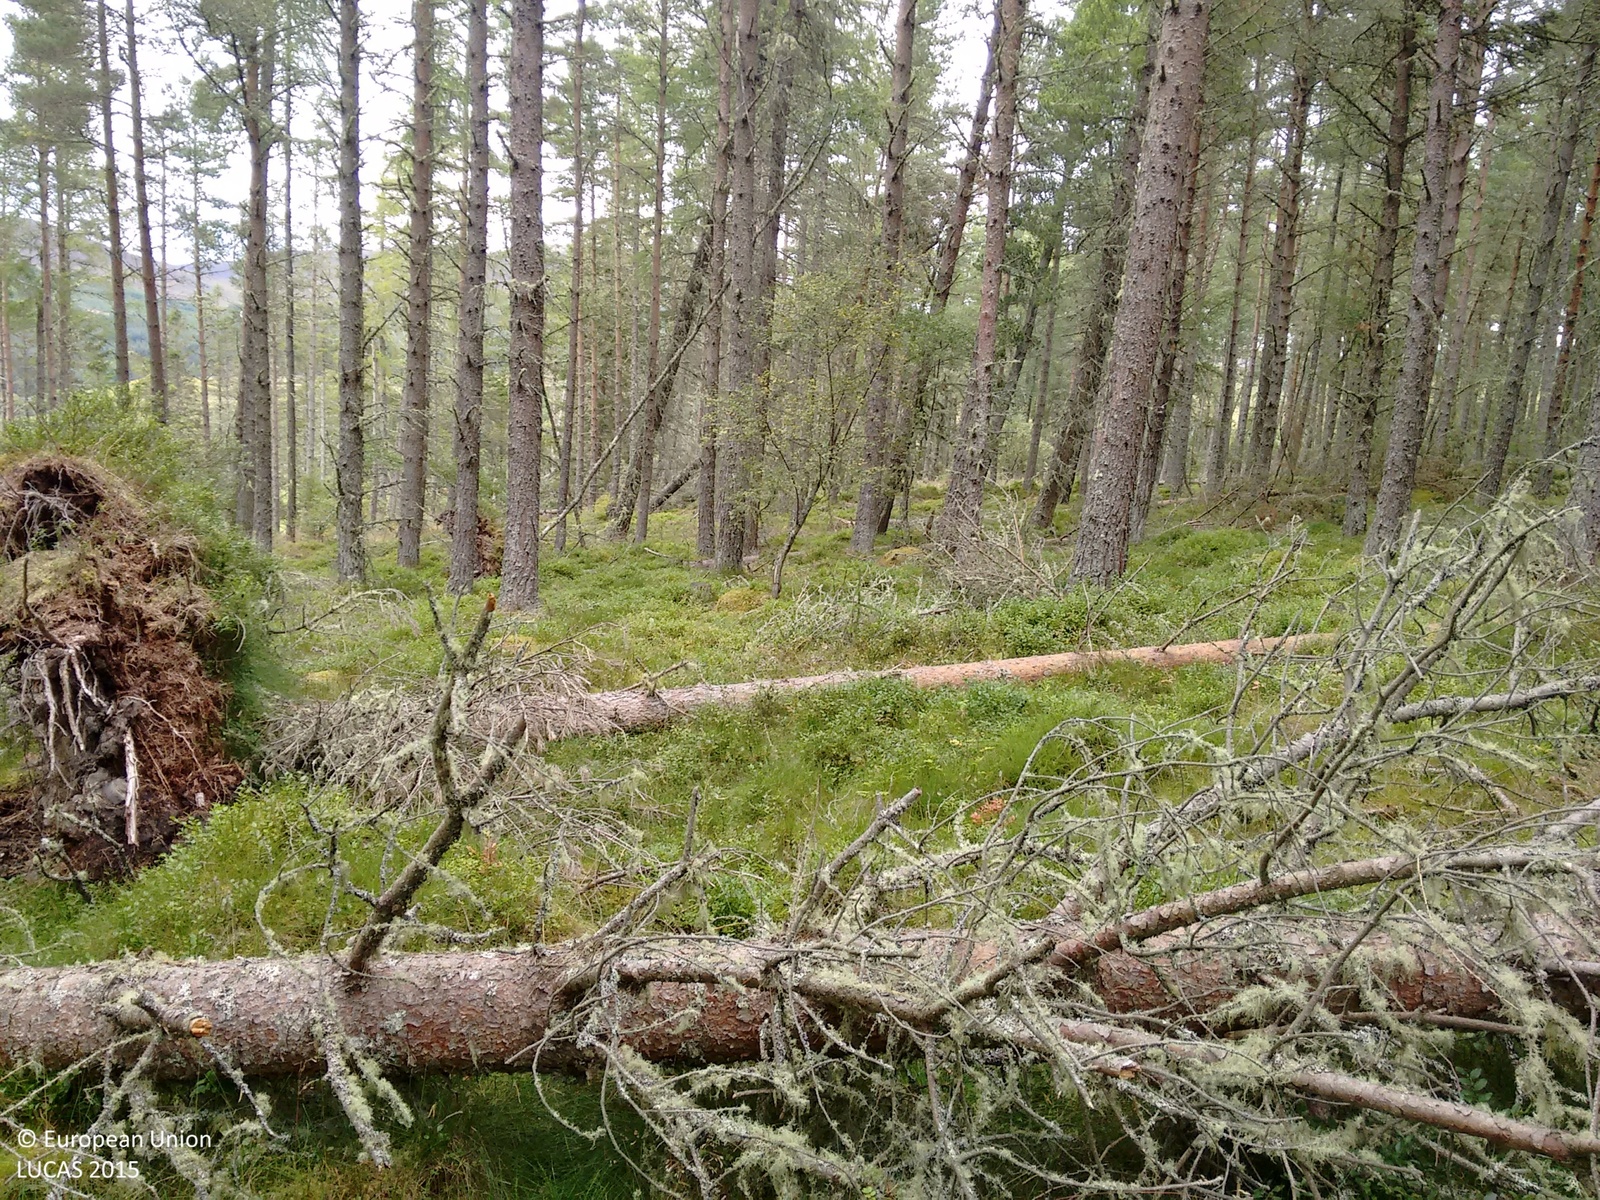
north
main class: Woodland
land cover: Pine dominated coniferous woodland
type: hemiboreal forest and nemoral coniferous forest and mixed broadleaved-coniferous forest
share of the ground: > 75 %
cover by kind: coniferous forest trees 80 %, shrubs 15 %, herbaceous plants 5 %
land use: Forestry
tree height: > 5 m
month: September
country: GB
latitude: 57.7407
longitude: -4.3135
